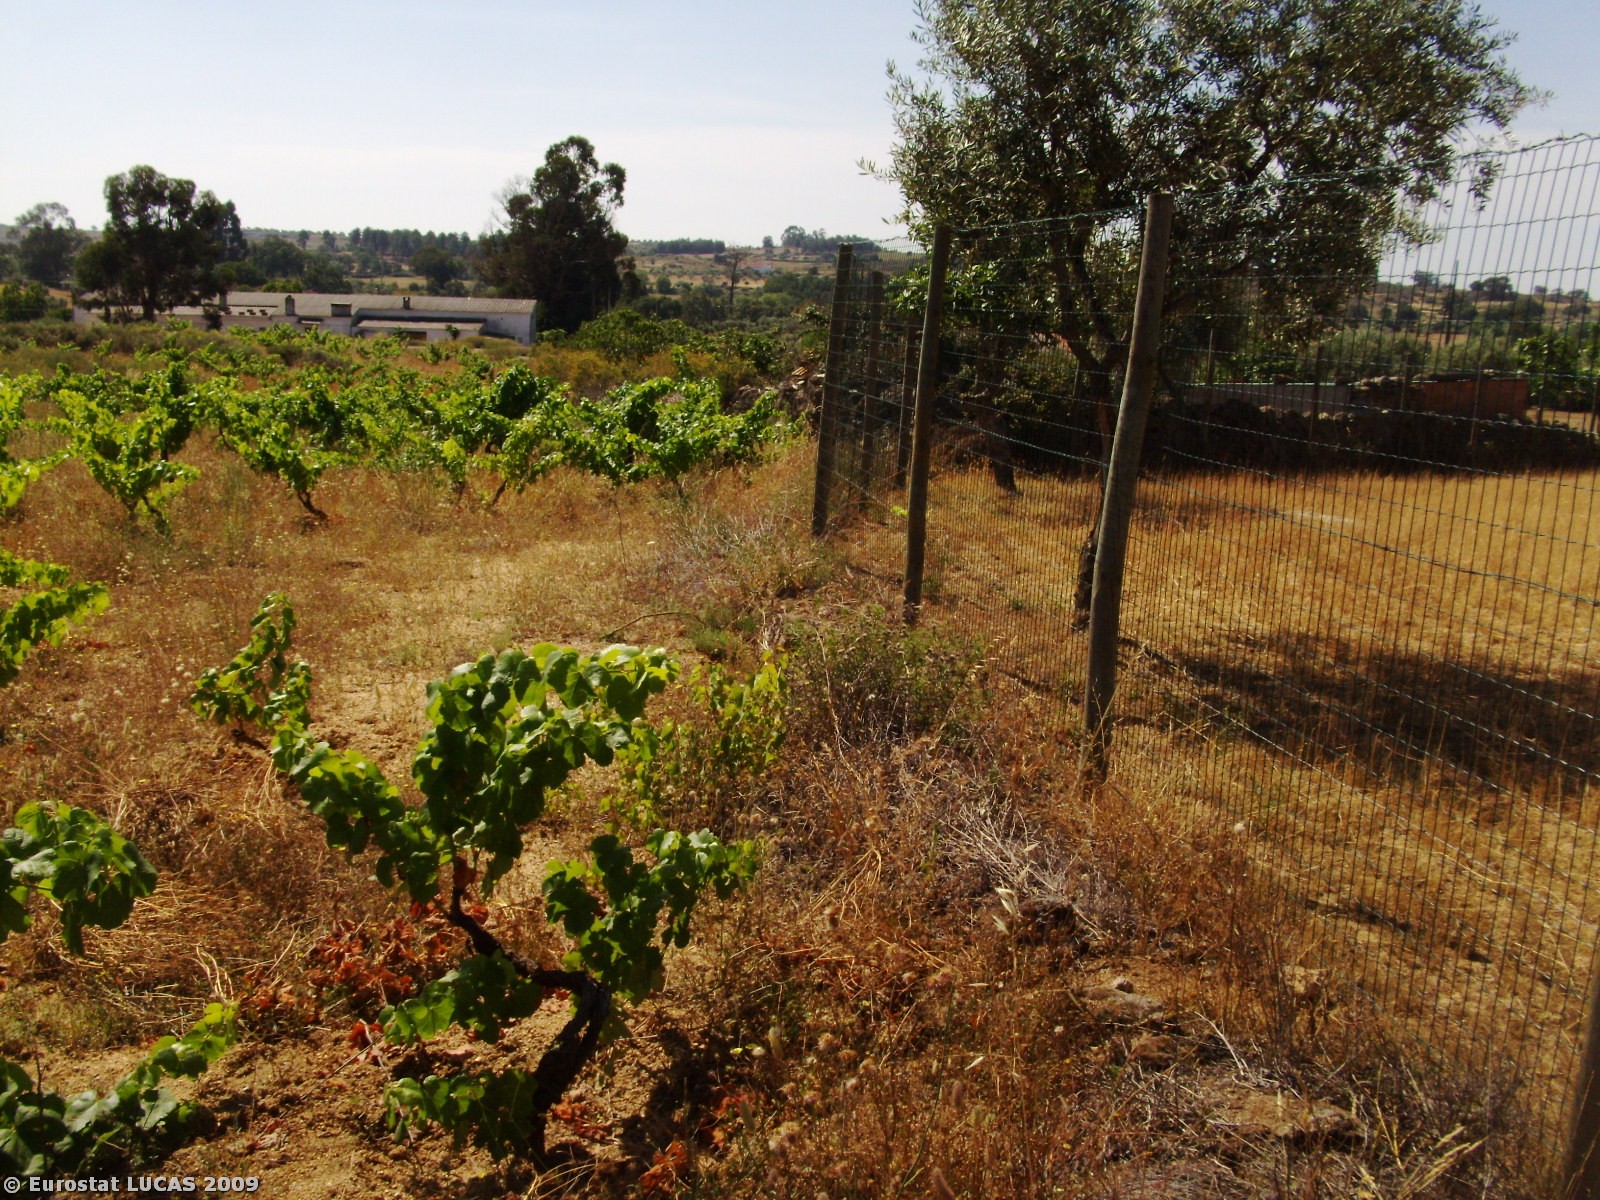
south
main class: Cropland
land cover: Olive groves
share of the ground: 50 - 75 %
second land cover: Spontaneously vegetated surfaces
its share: 25 - 50 %
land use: Agriculture (excluding fallow land and kitchen gardens)
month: June
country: PT
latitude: 40.0252
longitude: -7.3113
